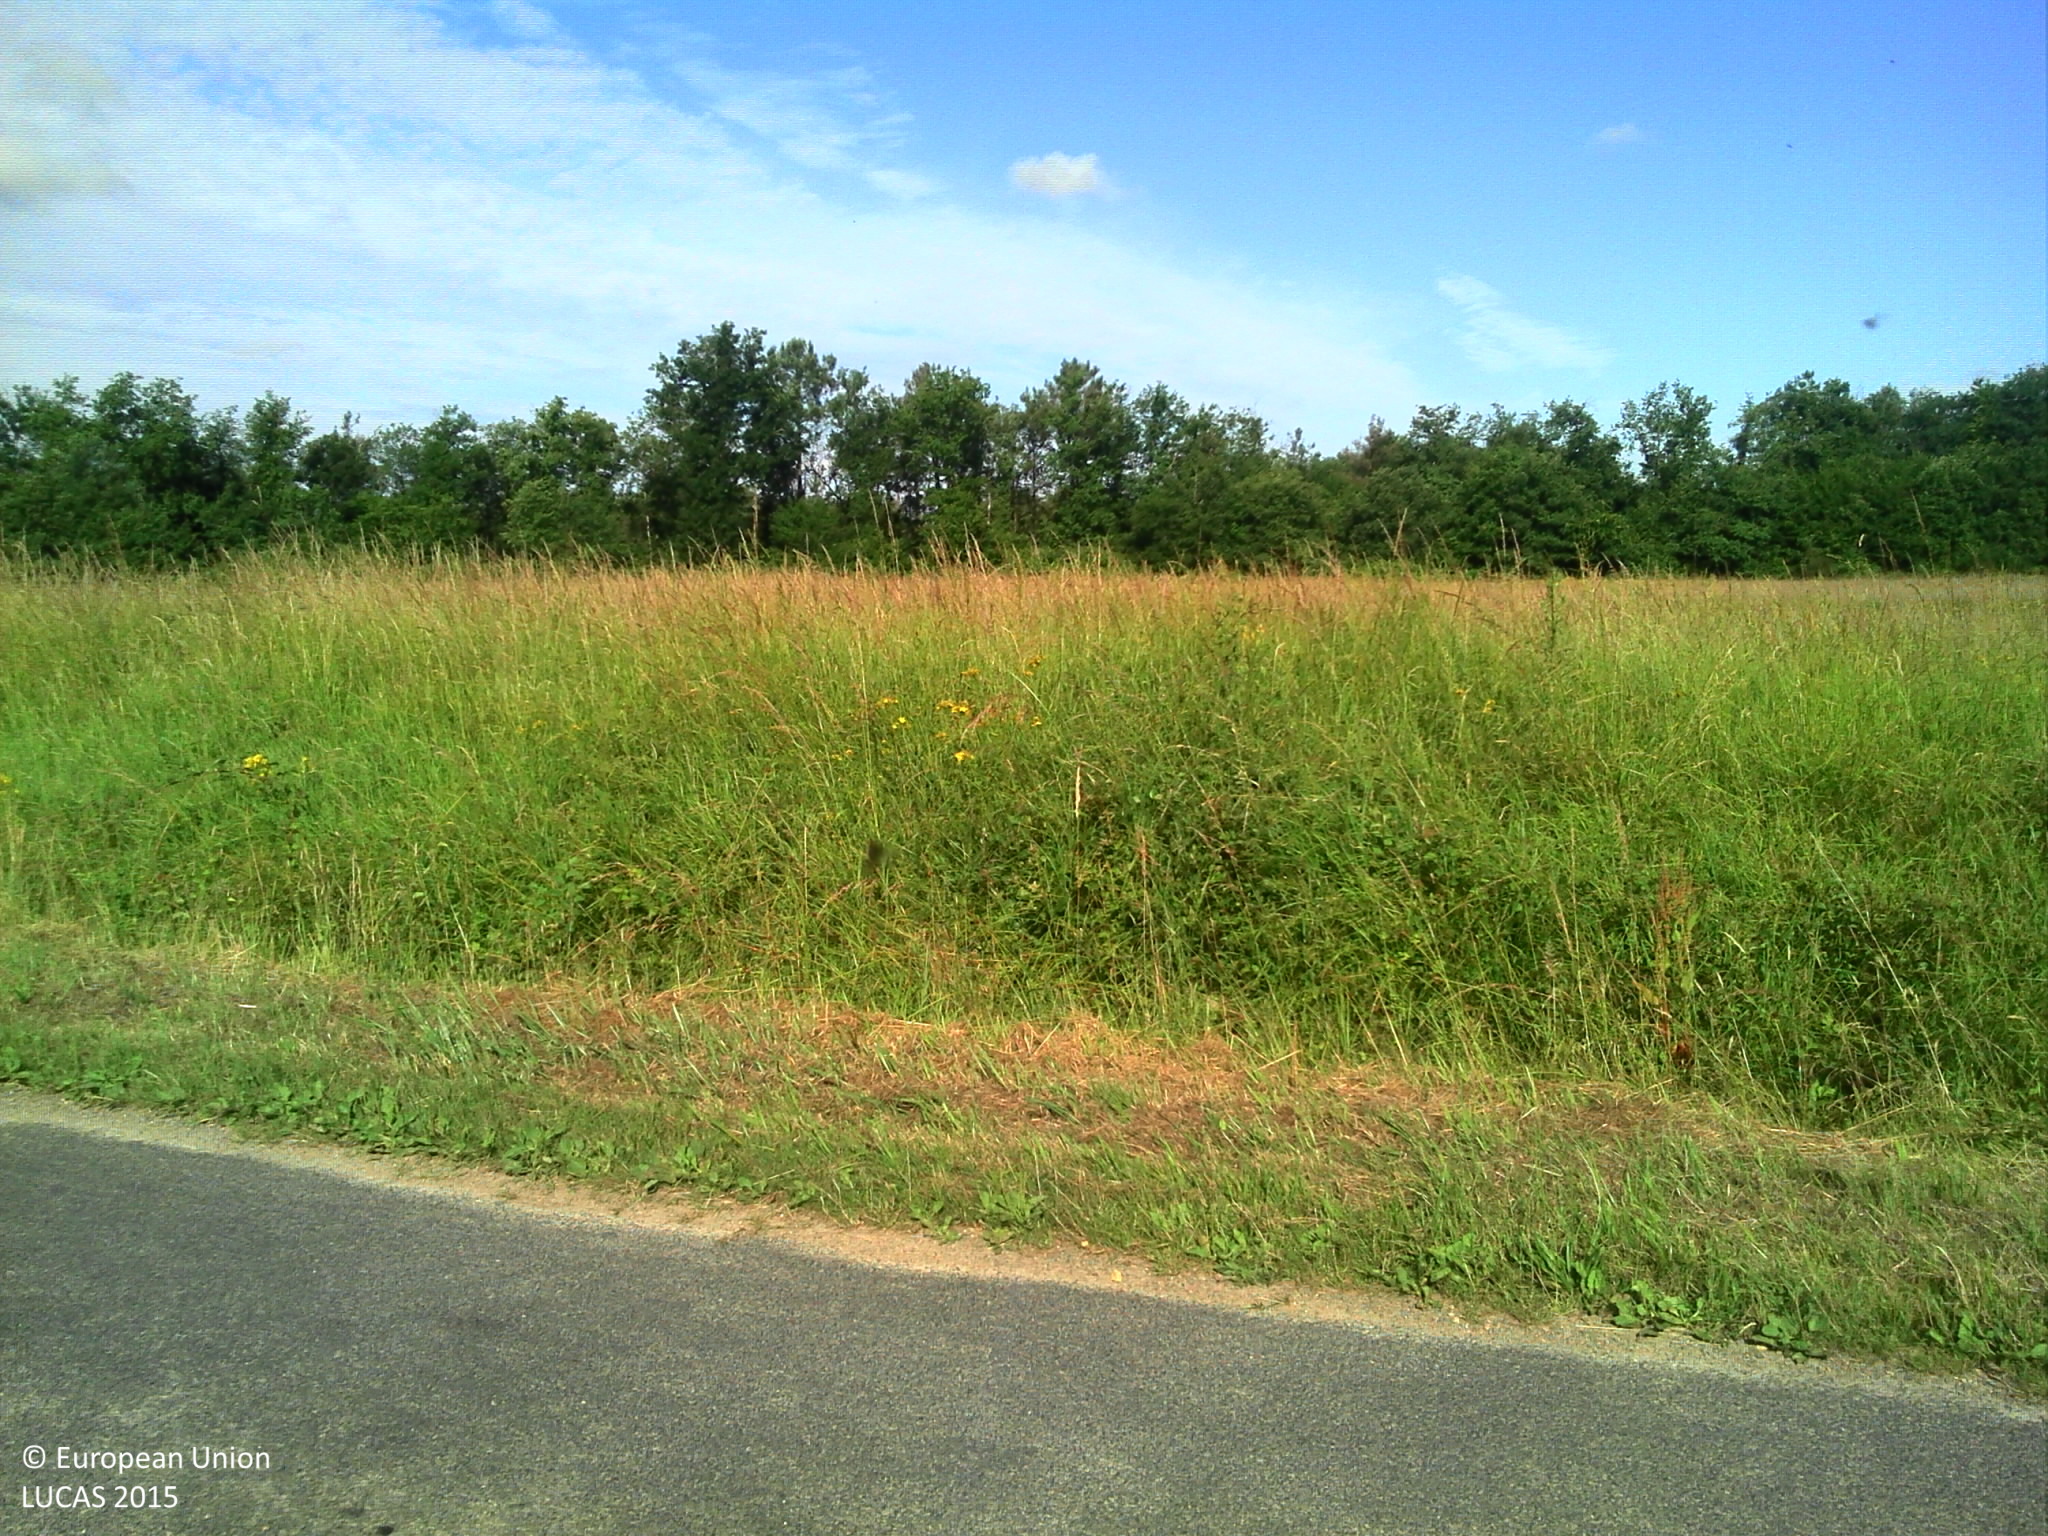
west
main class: Cropland
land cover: Durum wheat
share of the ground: > 75 %
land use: Agriculture (excluding fallow land and kitchen gardens)
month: June
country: FR
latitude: 46.6735
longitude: 0.5311
